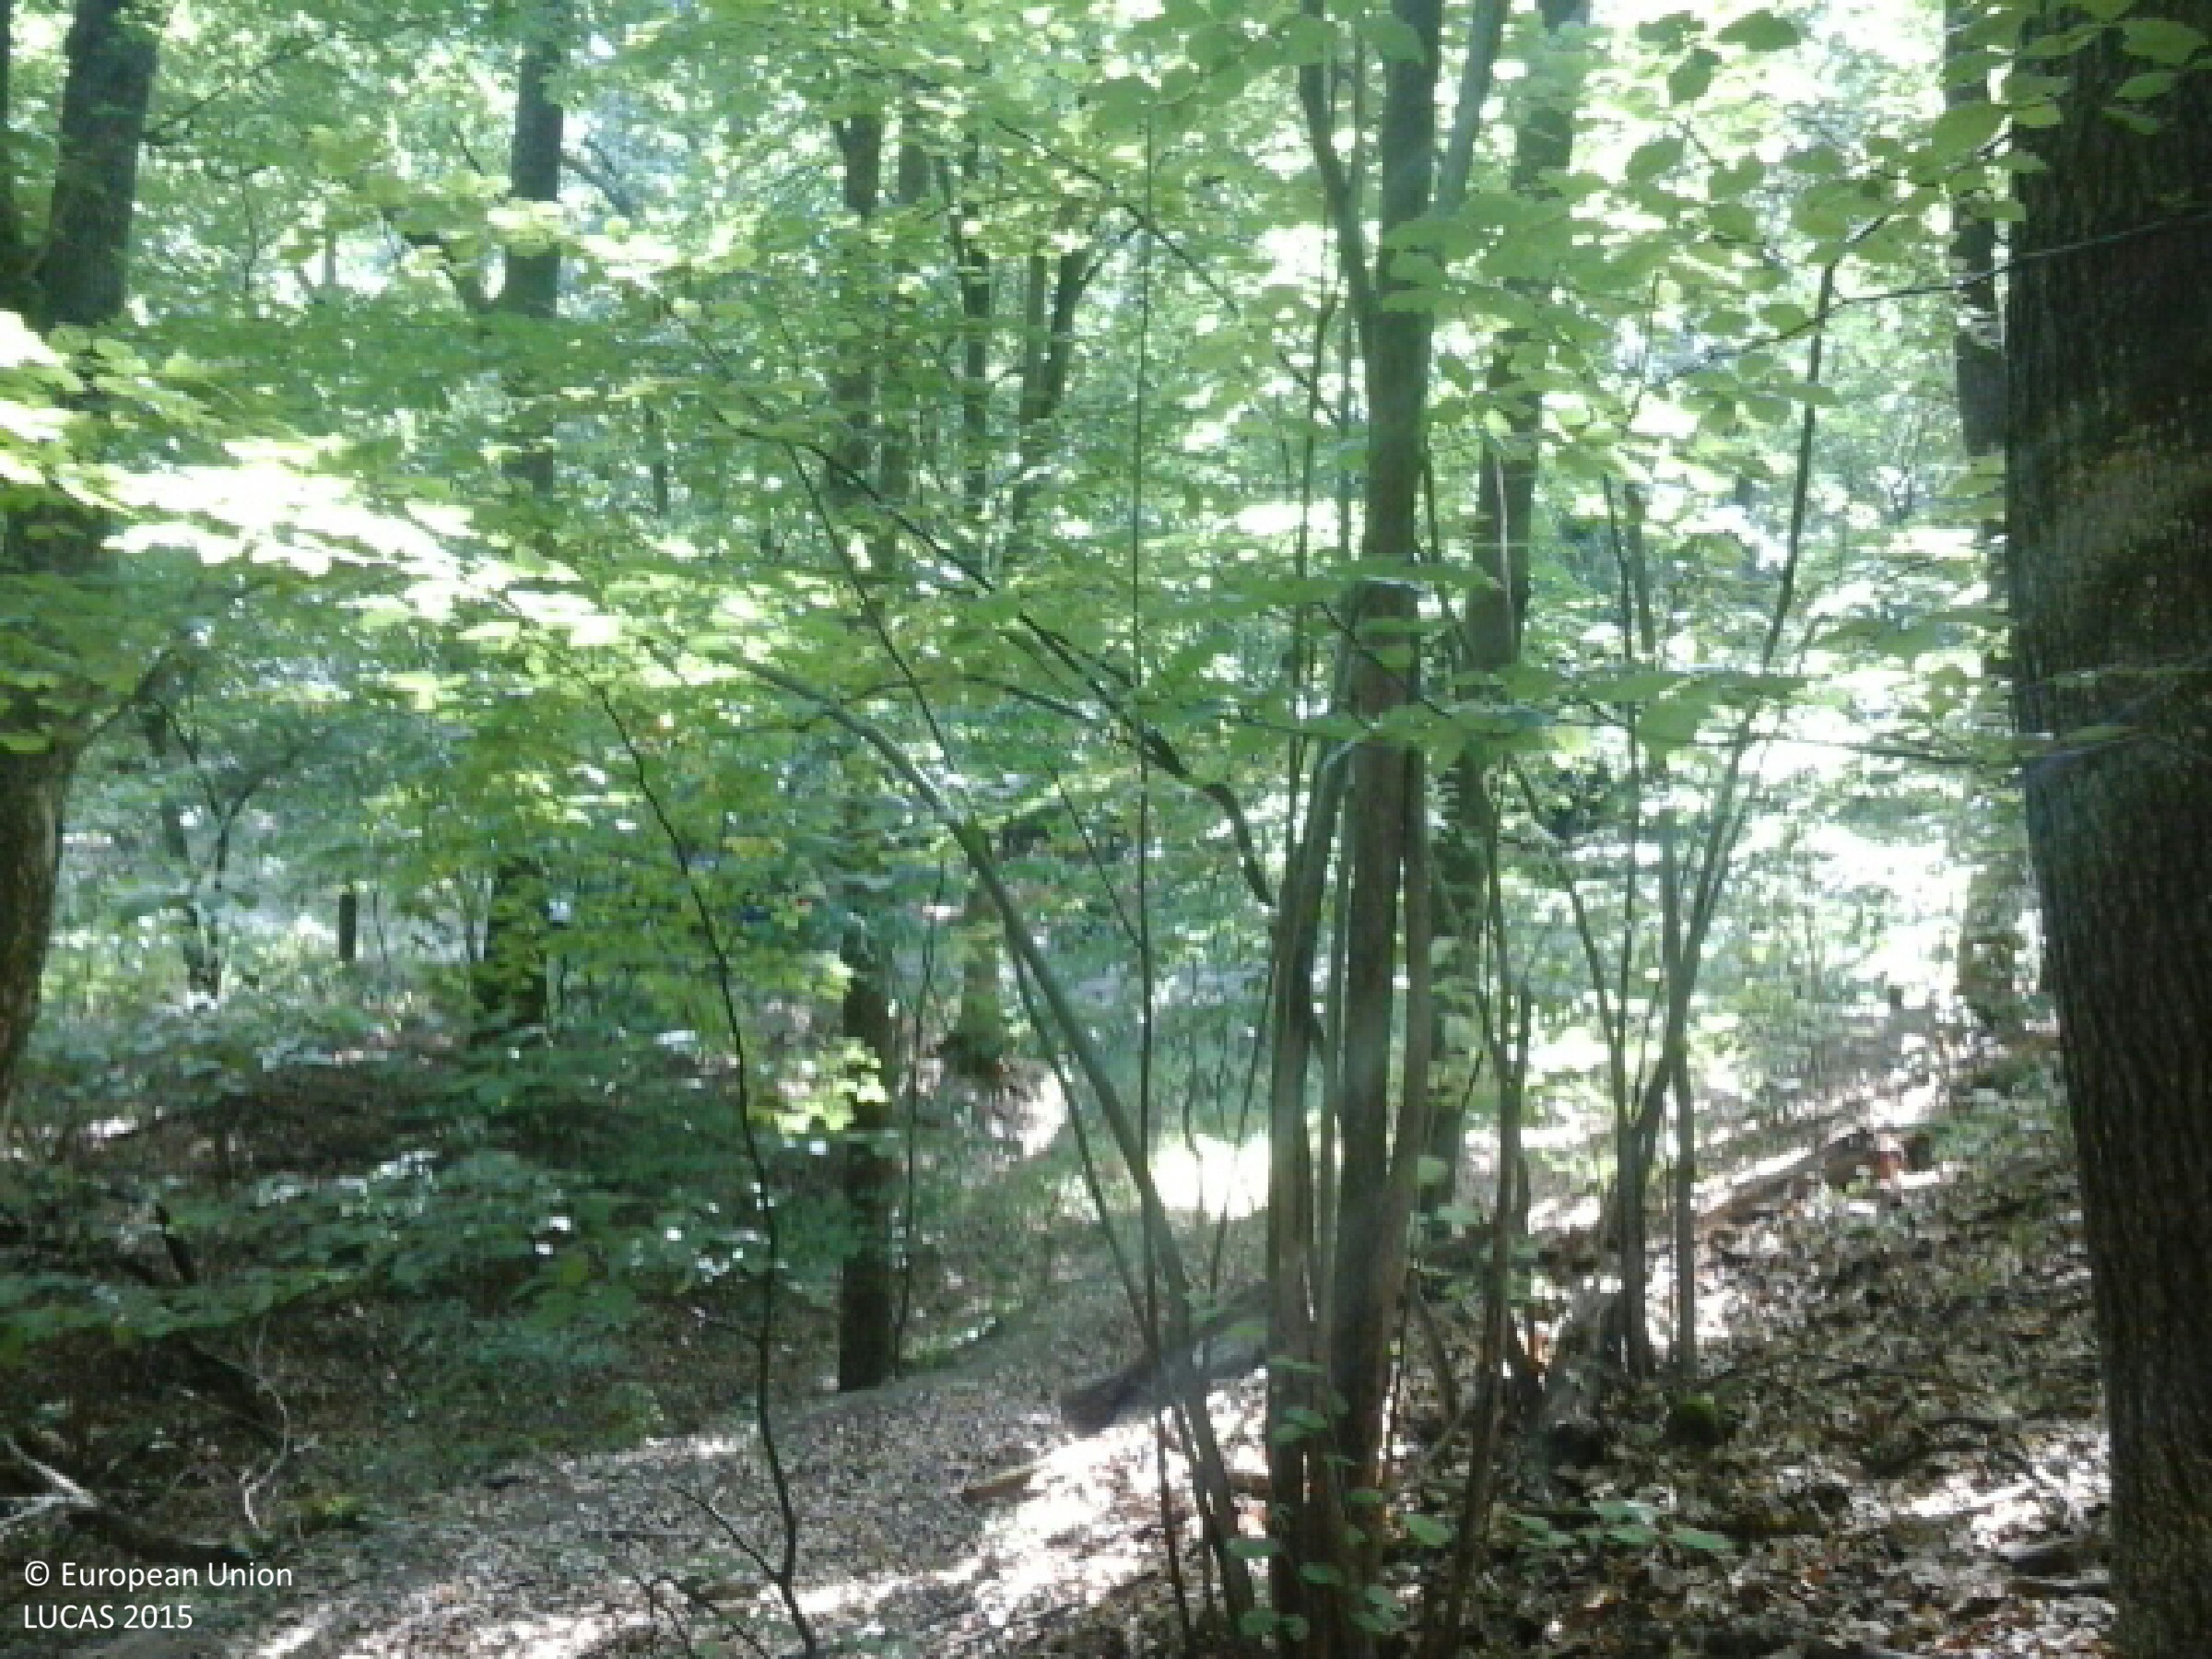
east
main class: Woodland
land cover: Broadleaved woodland
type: mesophytic deciduous forest
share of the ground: > 75 %
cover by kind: broadleaved forest trees 100 %
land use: Forestry
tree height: > 5 m
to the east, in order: Broadleaved woodland; Ditches and canals; Tracks; Broadleaved woodland
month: July
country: HU
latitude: 48.3789
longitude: 21.5370
